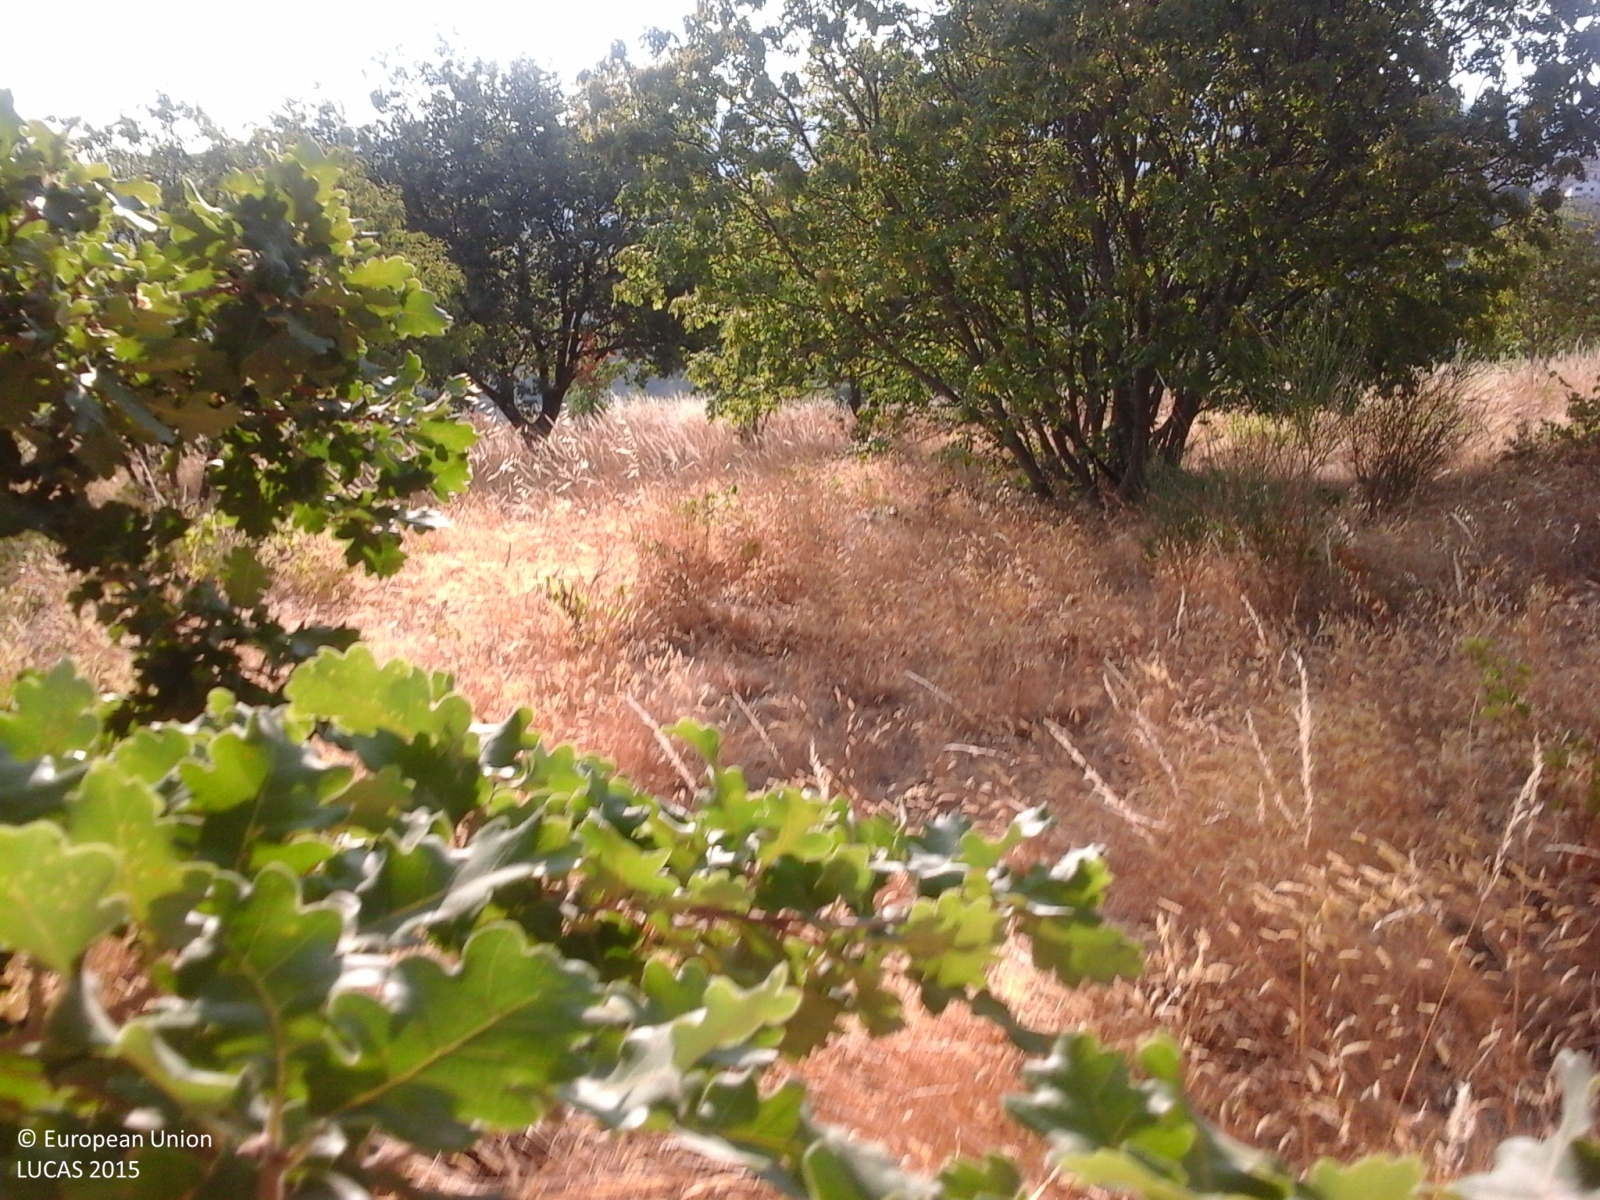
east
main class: Grassland
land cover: Grassland with sparse tree/shrub cover
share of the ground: > 75 %
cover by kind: herbaceous plants 85 %, shrubs 10 %, broadleaved forest trees 5 %
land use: Abandoned areas
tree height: < 5 m
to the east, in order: Grassland with sparse tree/shrub cover; Grassland without tree/shrub cover; Shrubland with sparse tree cover; Electric lines; Olive groves; Grassland with sparse tree/shrub cover; Grass margins; Paved roads, cycling and walking lanes; Fences; Grassland with sparse tree/shrub cover; Olive groves; Fences; Vineyards; Grassland with sparse tree/shrub cover; Fences; Grass margins; Paved roads, cycling and walking lanes; Fences; Grassland without tree/shrub cover; Artificial constructions in urban areas; Abandoned hedges; Other fresh vegetables; Other fruit trees and berries; Broadleaved woodland
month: July
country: IT
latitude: 42.8954
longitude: 11.5259
